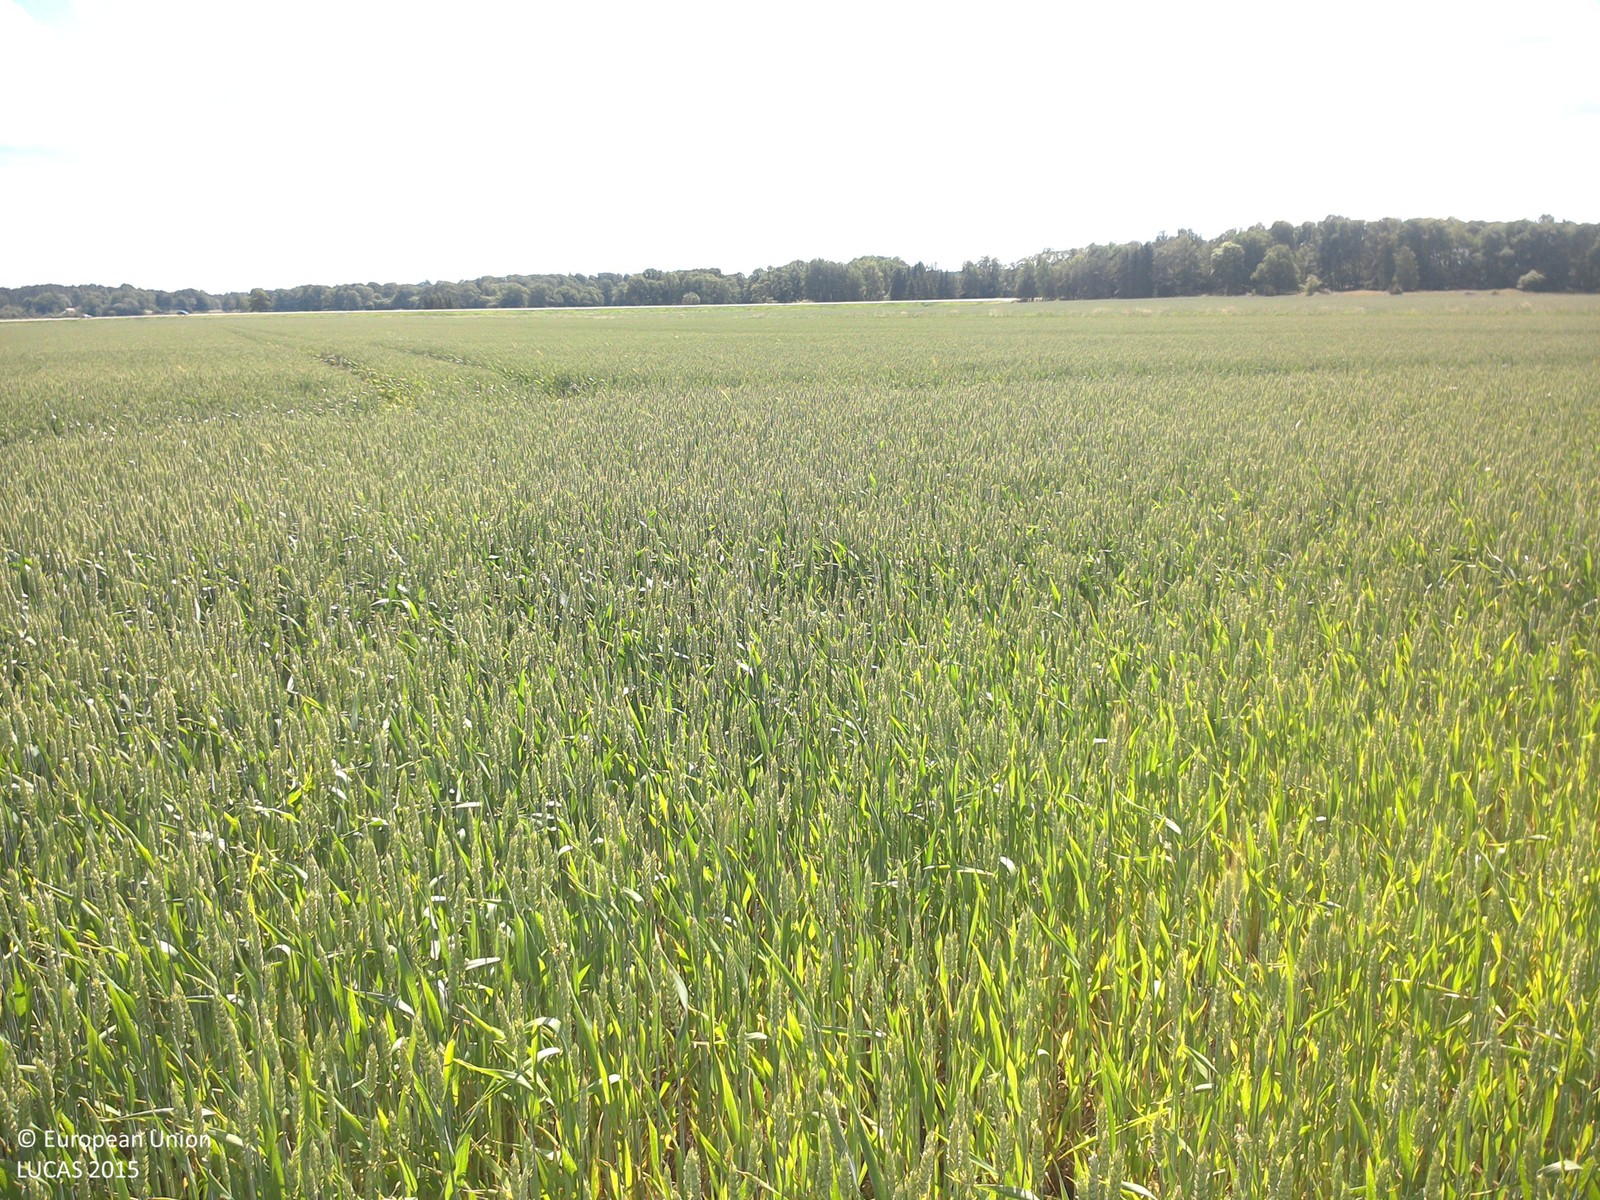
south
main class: Cropland
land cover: Common wheat
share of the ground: > 75 %
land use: Agriculture (excluding fallow land and kitchen gardens)
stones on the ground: < 10 %
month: July
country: SE
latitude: 58.3782
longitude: 15.4836
